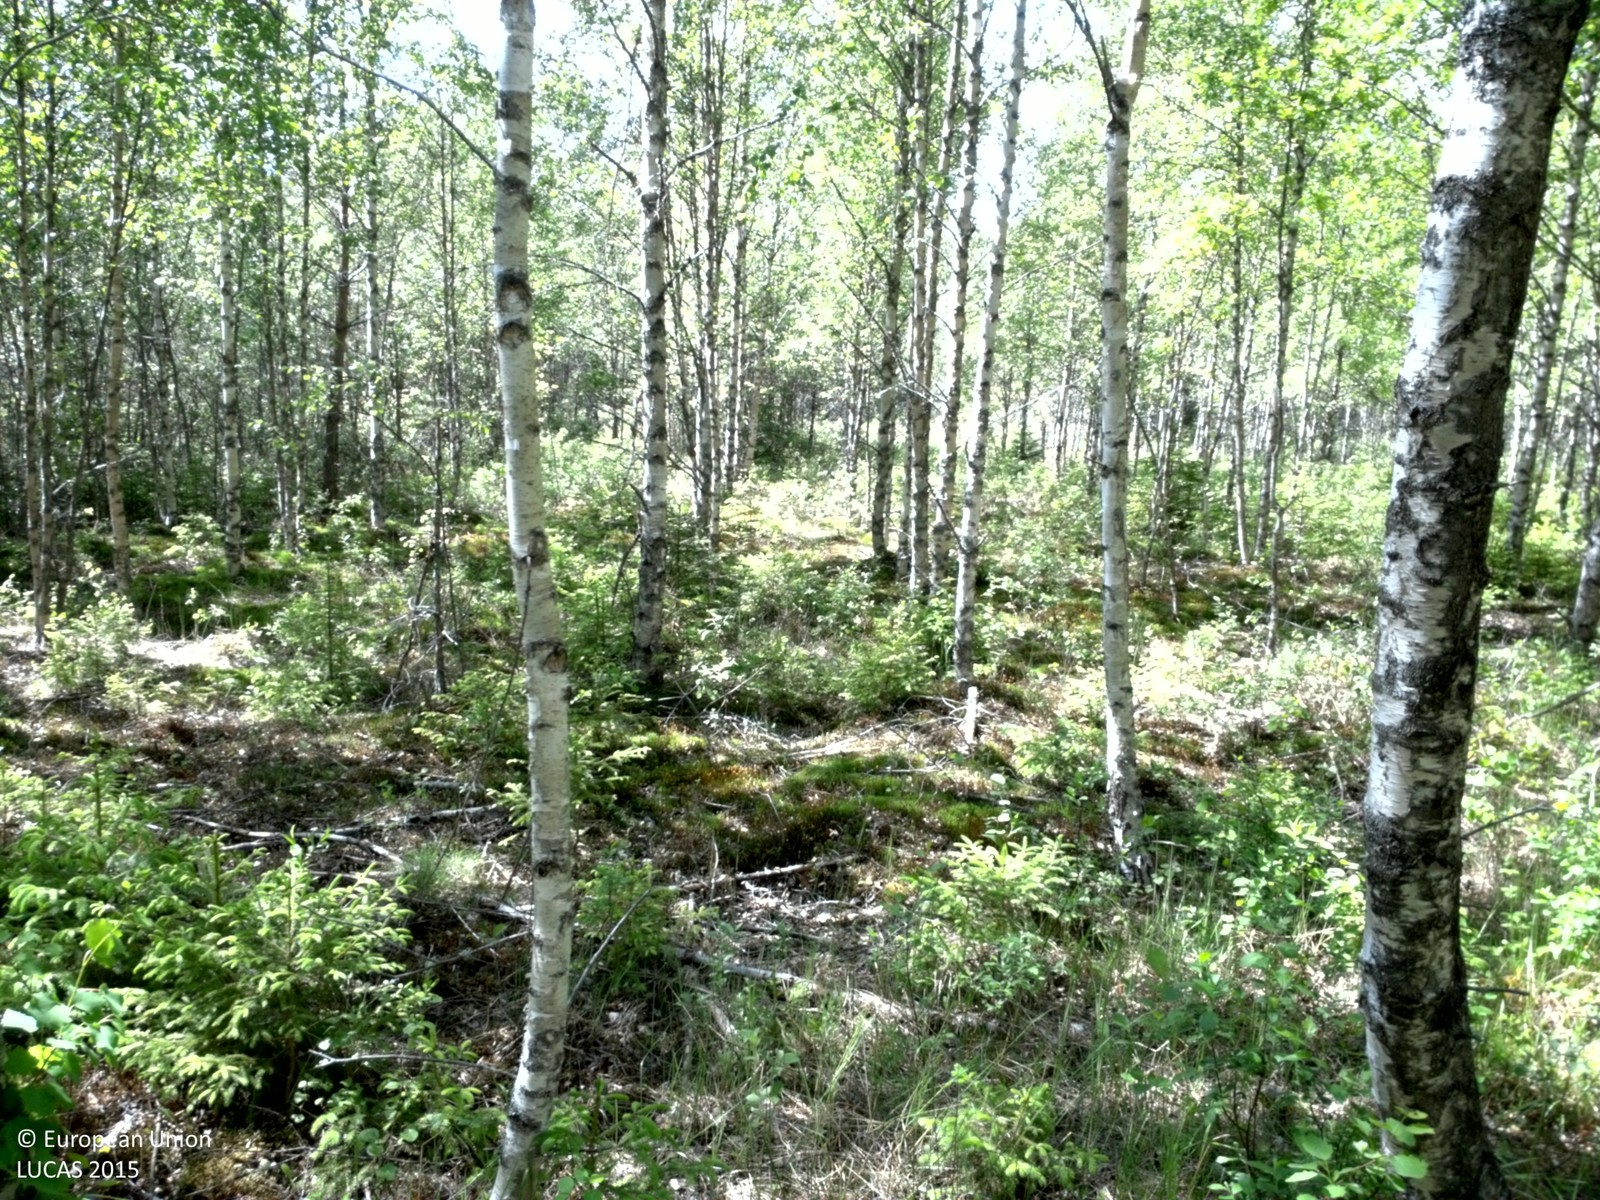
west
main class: Woodland
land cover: Broadleaved woodland
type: acidophilous oak and oak-birch forest
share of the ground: 25 - 50 %
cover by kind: herbaceous plants 50 %, broadleaved forest trees 35 %, lichens and mosses 10 %, coniferous forest trees 5 %
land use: Forestry
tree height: > 5 m
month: June
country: SE
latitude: 58.6875
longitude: 16.2571
